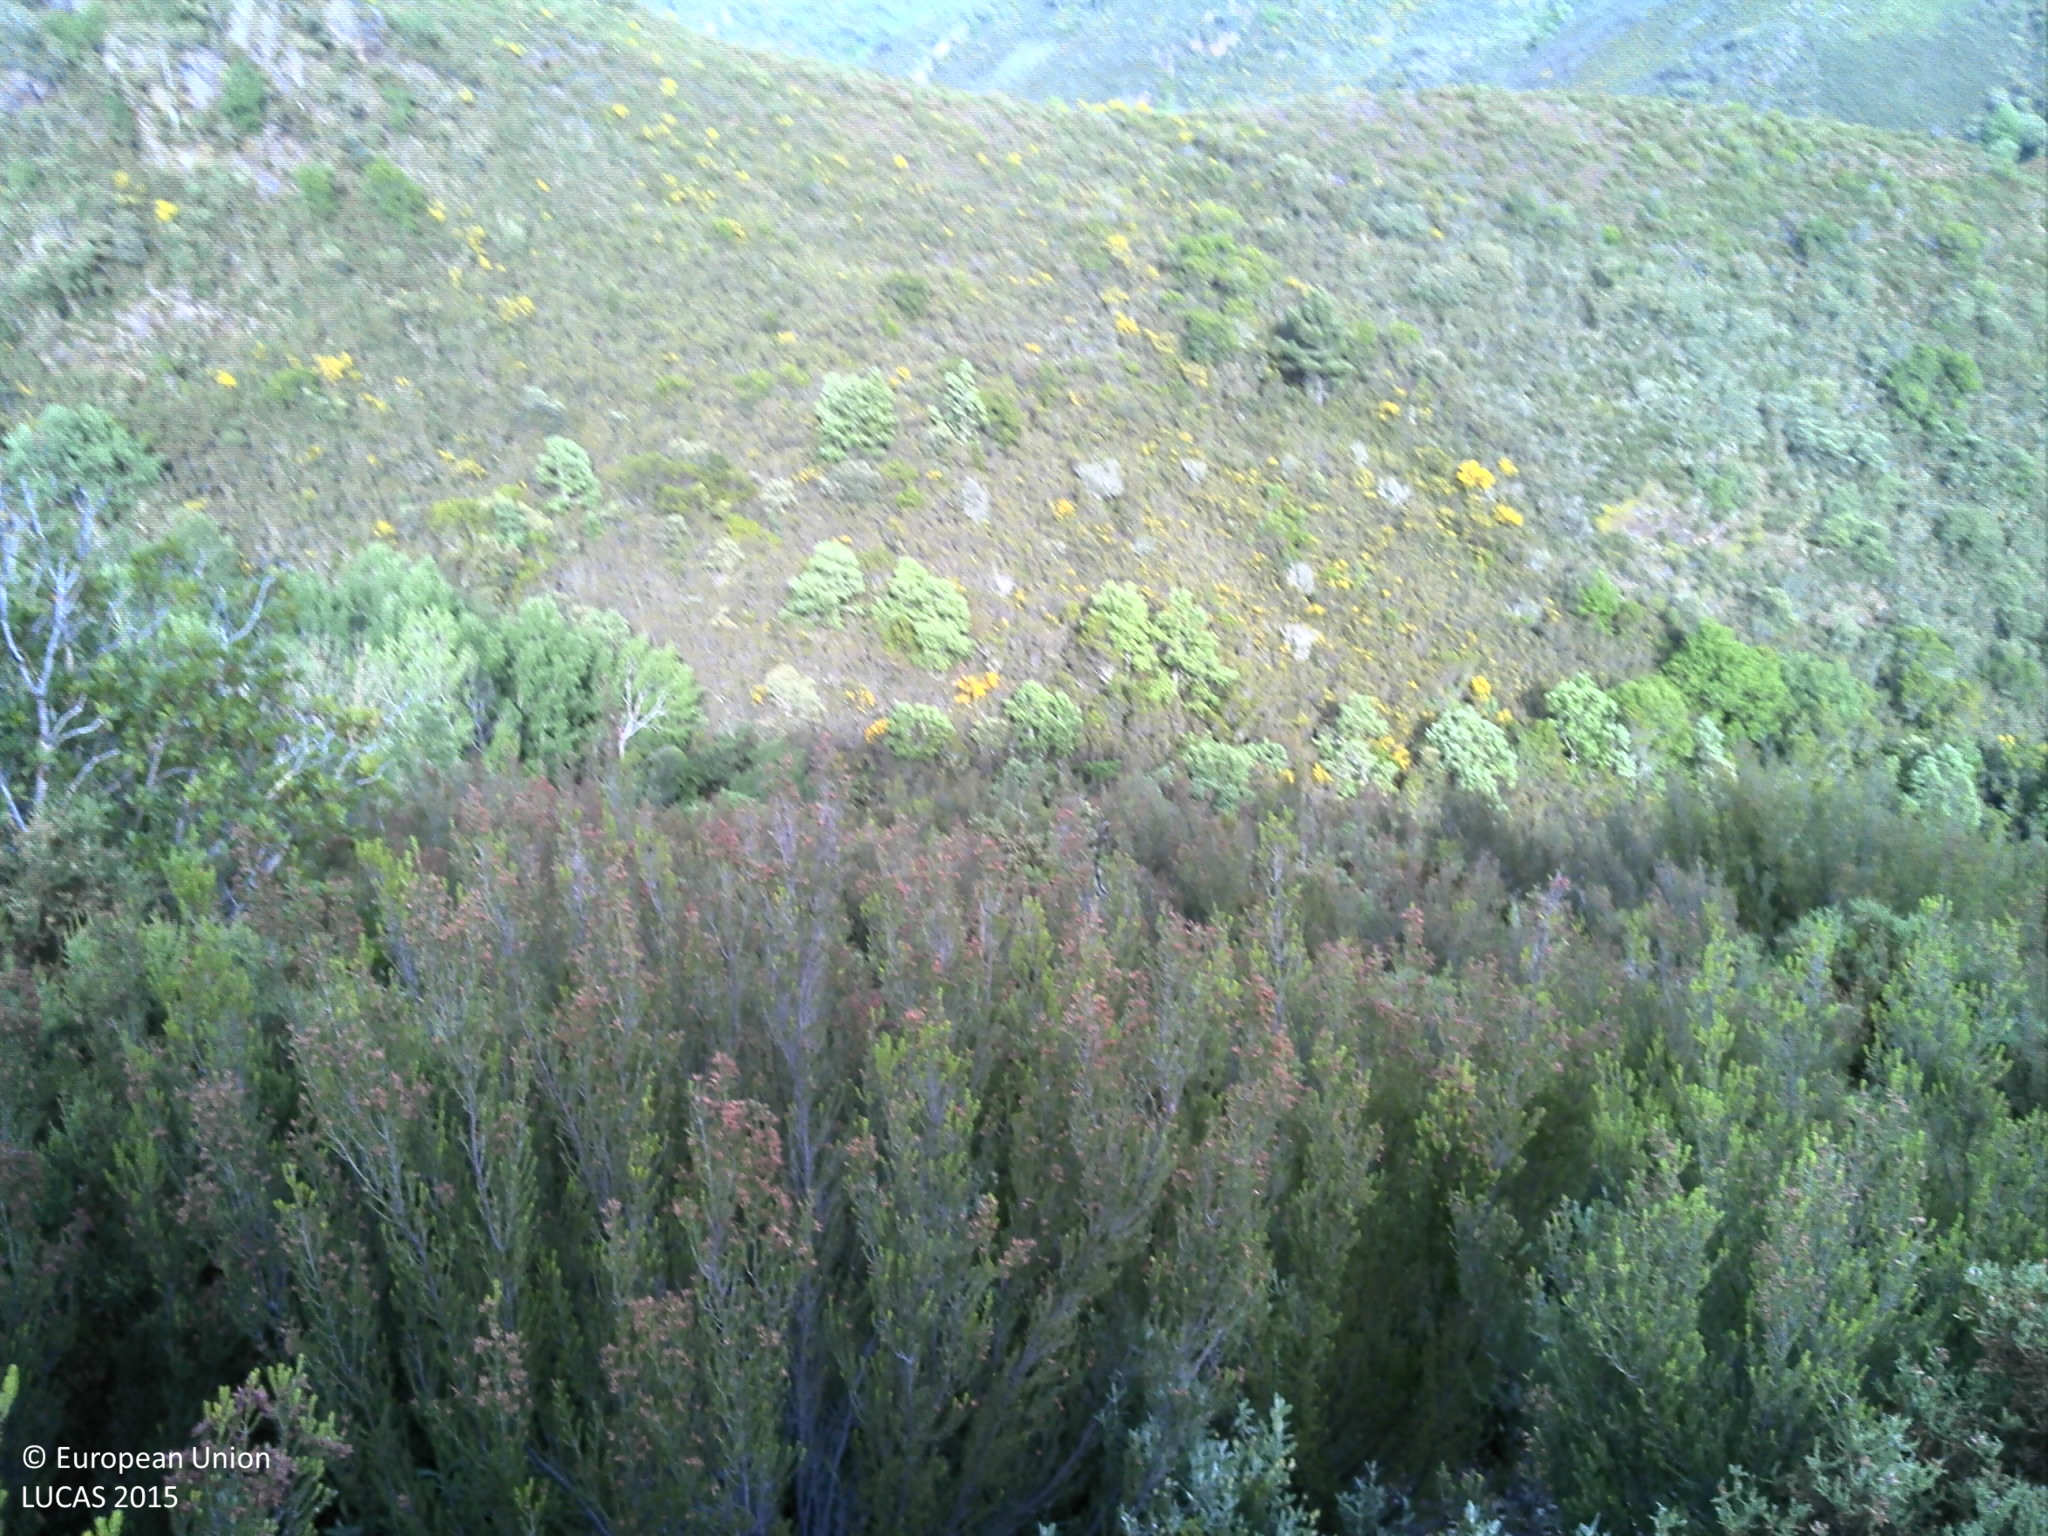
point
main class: Shrubland
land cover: Shrubland with sparse tree cover
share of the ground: > 75 %
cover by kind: shrubs 85 %, unconsolidated bare surface 10 %, broadleaved forest trees 5 %
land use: Forestry
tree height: > 5 m
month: May
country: PT
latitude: 41.7231
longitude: -6.9827
